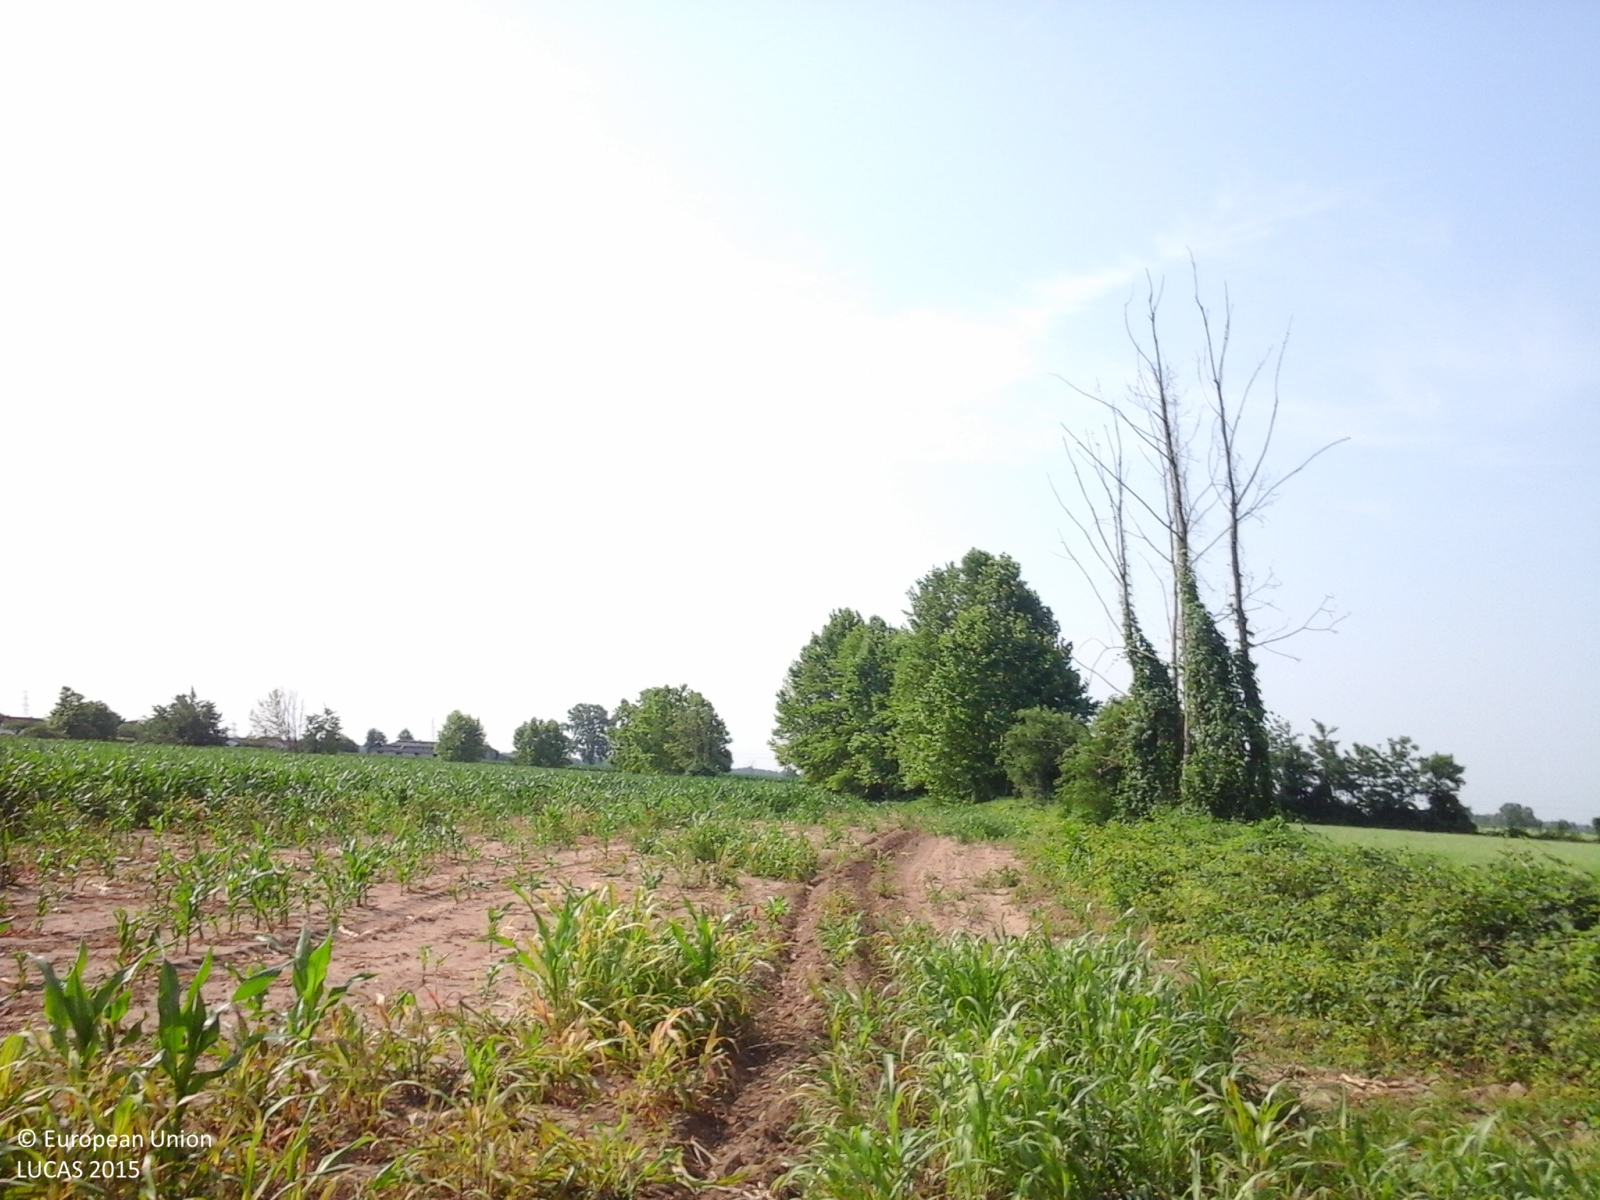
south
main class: Cropland
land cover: Maize
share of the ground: > 75 %
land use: Agriculture (excluding fallow land and kitchen gardens)
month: June
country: IT
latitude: 45.3236
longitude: 9.6562
